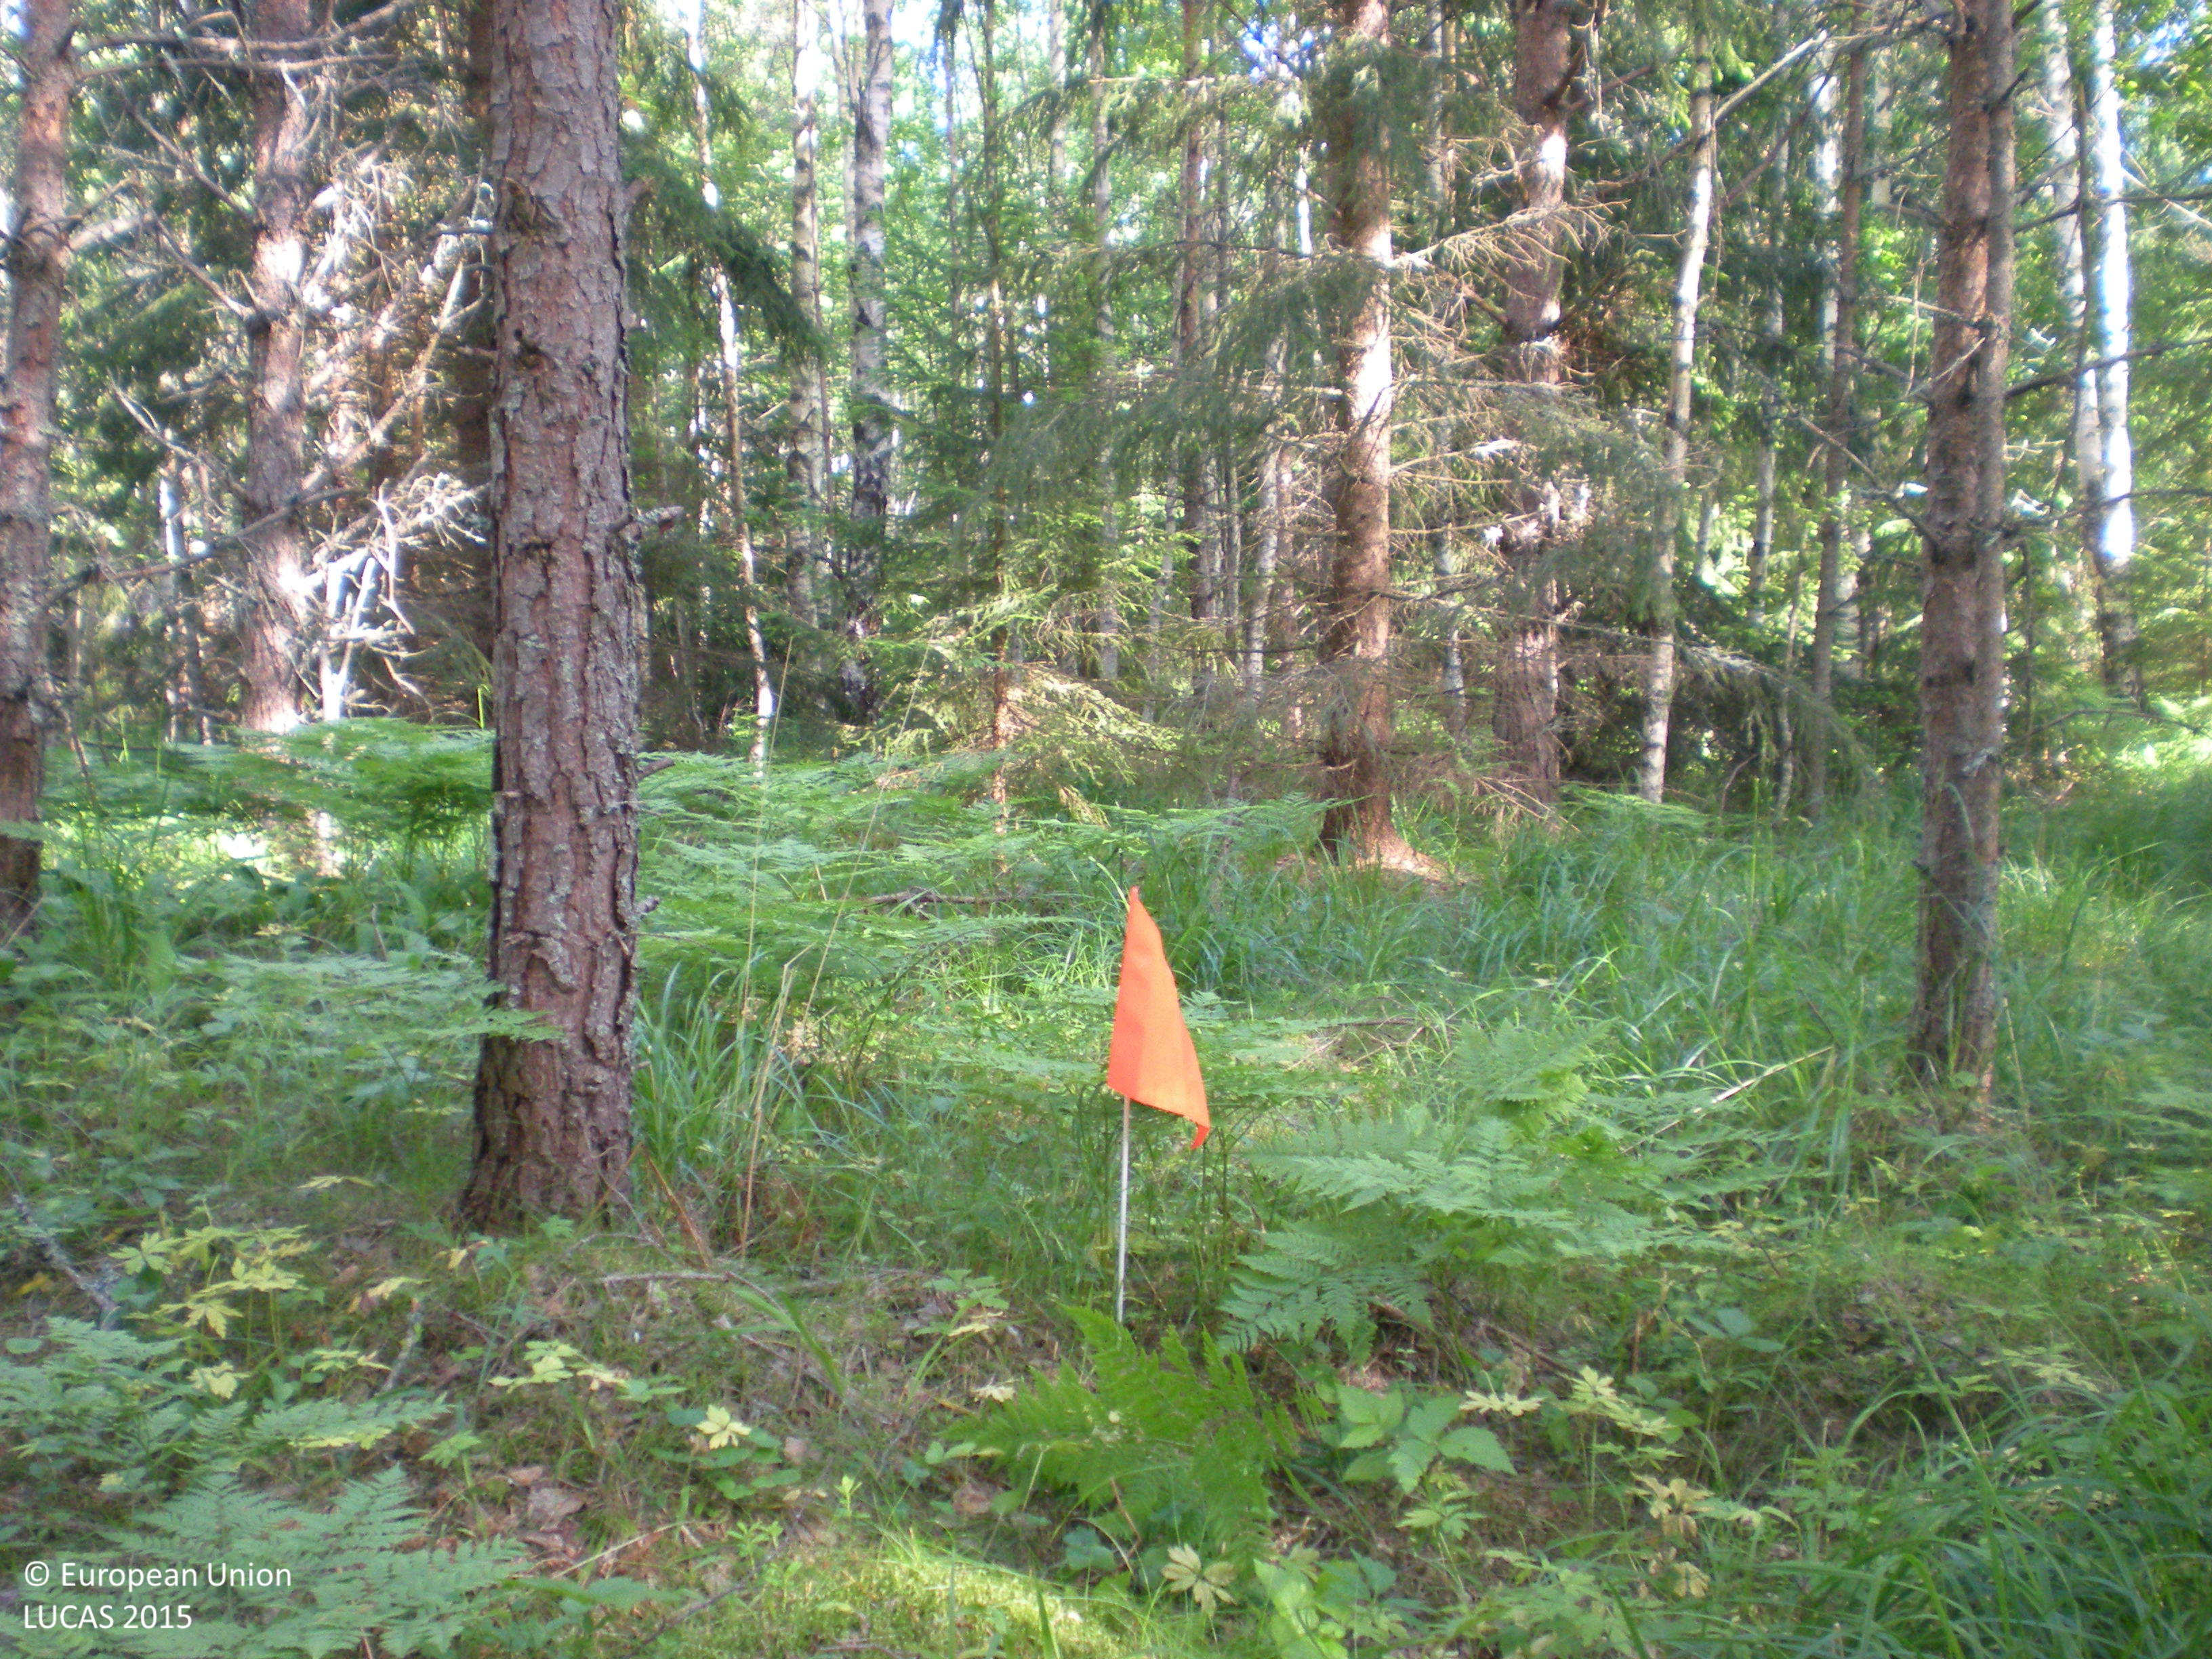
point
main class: Woodland
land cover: Other coniferous woodland
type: boreal forest
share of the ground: 50 - 75 %
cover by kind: coniferous forest trees 70 %, broadleaved forest trees 10 %, herbaceous plants 10 %, shrubs 5 %, lichens and mosses 5 %
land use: Forestry
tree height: > 5 m
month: June
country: SE
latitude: 60.3525
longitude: 17.9858
